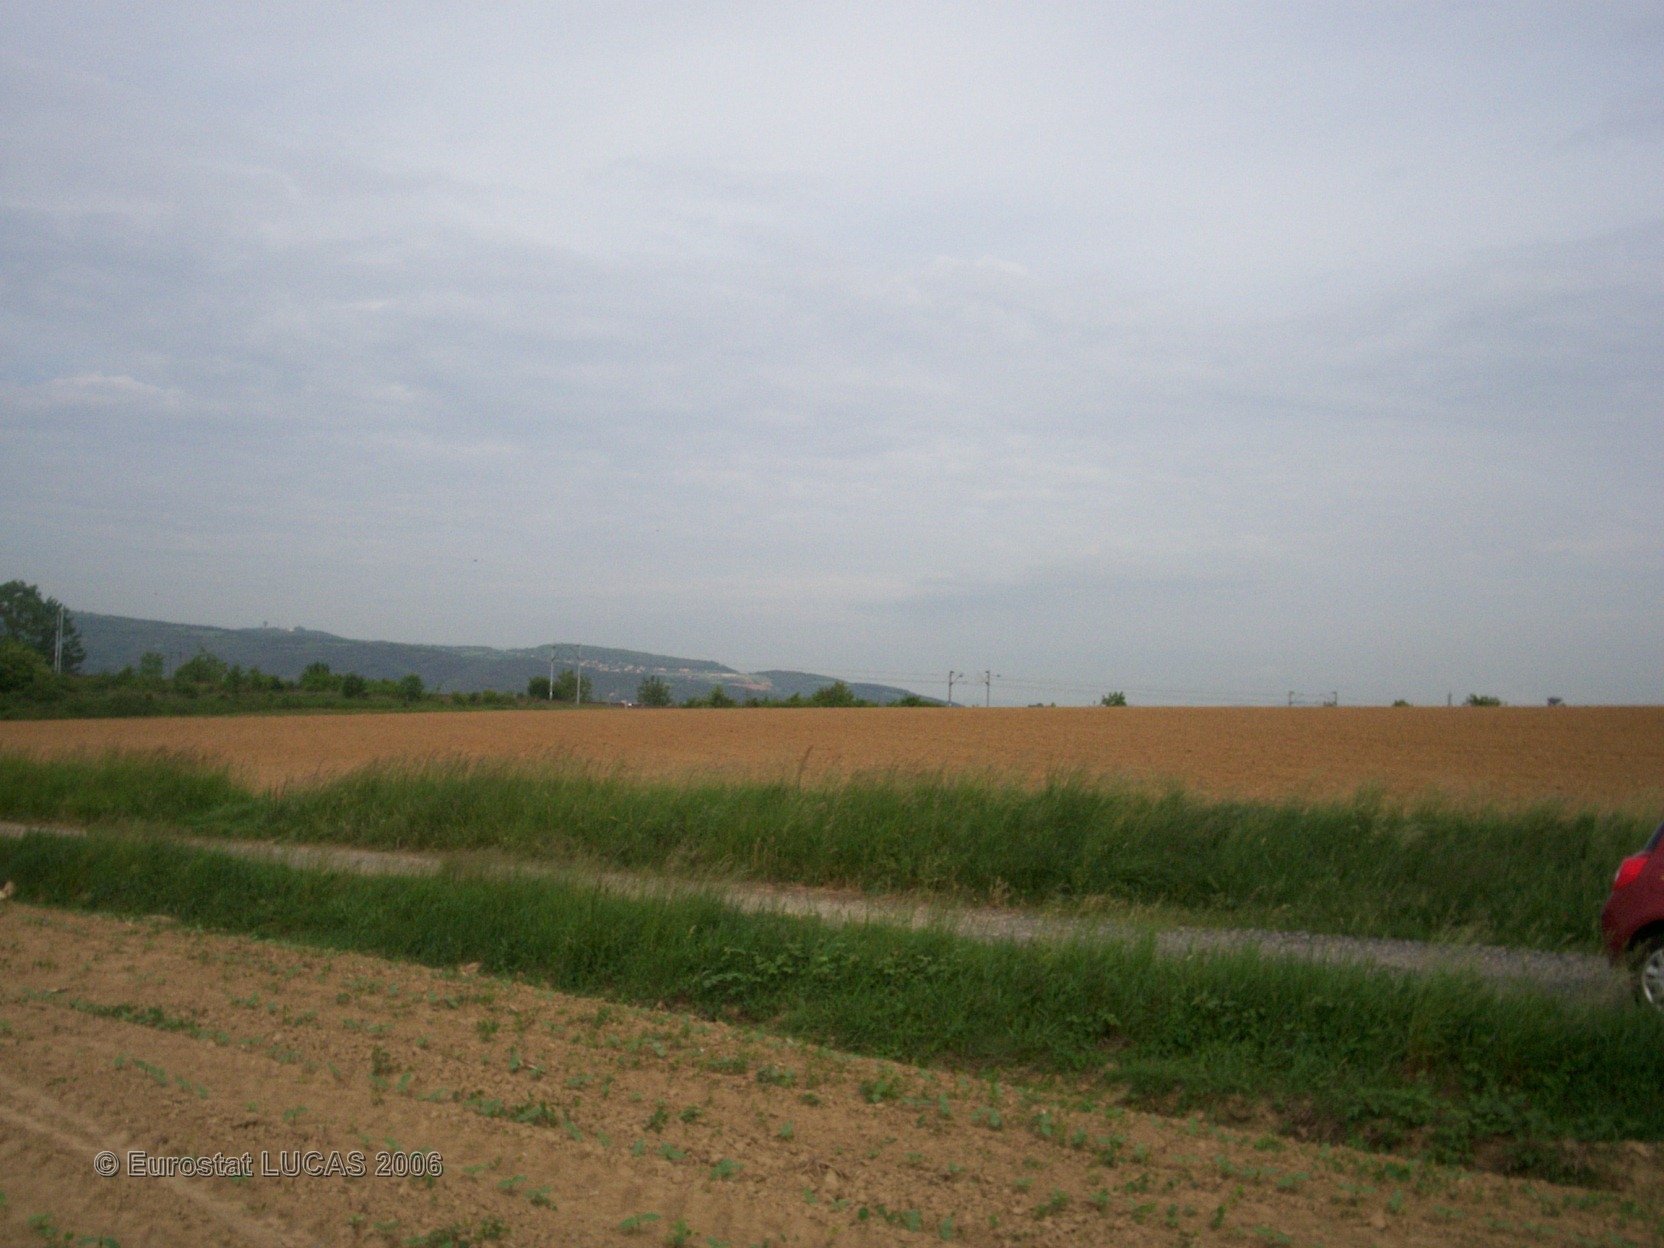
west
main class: Cropland
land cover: Soya
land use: Agriculture (excluding fallow land and kitchen gardens)
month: May
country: FR
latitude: 45.8501
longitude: 4.8910
